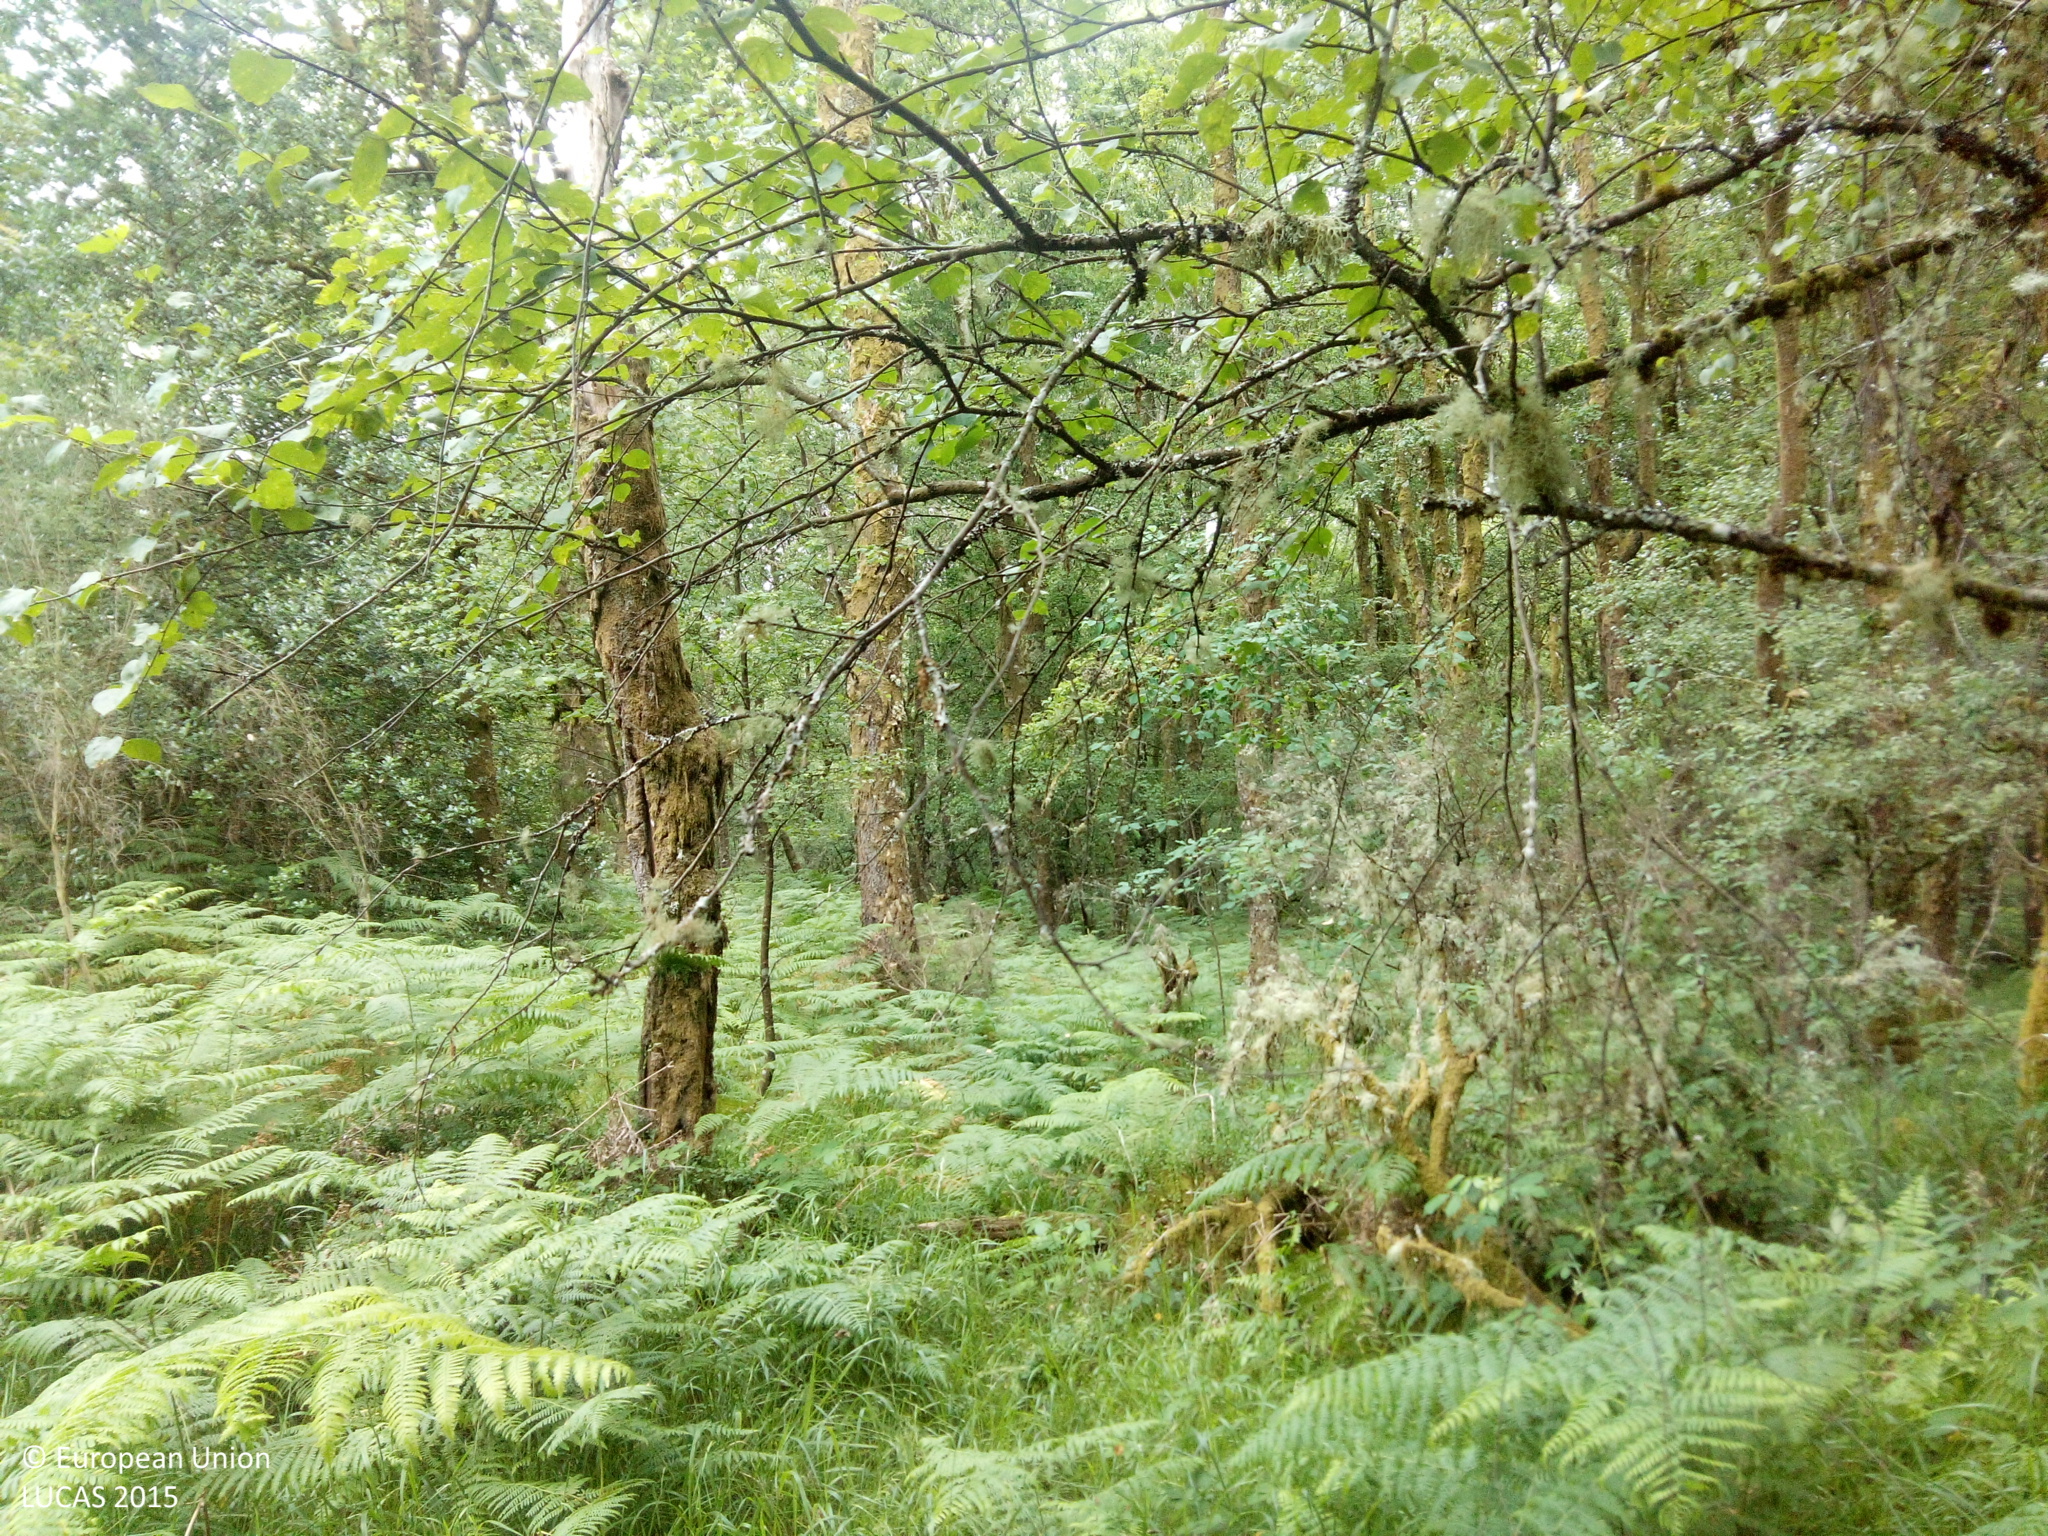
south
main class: Shrubland
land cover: Shrubland without tree cover
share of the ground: 10 - 25 %
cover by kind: consolidated bare surface 80 %, shrubs 20 %
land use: Semi-natural and natural areas not in use
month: July
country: ES
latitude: 42.2742
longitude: -8.2382
